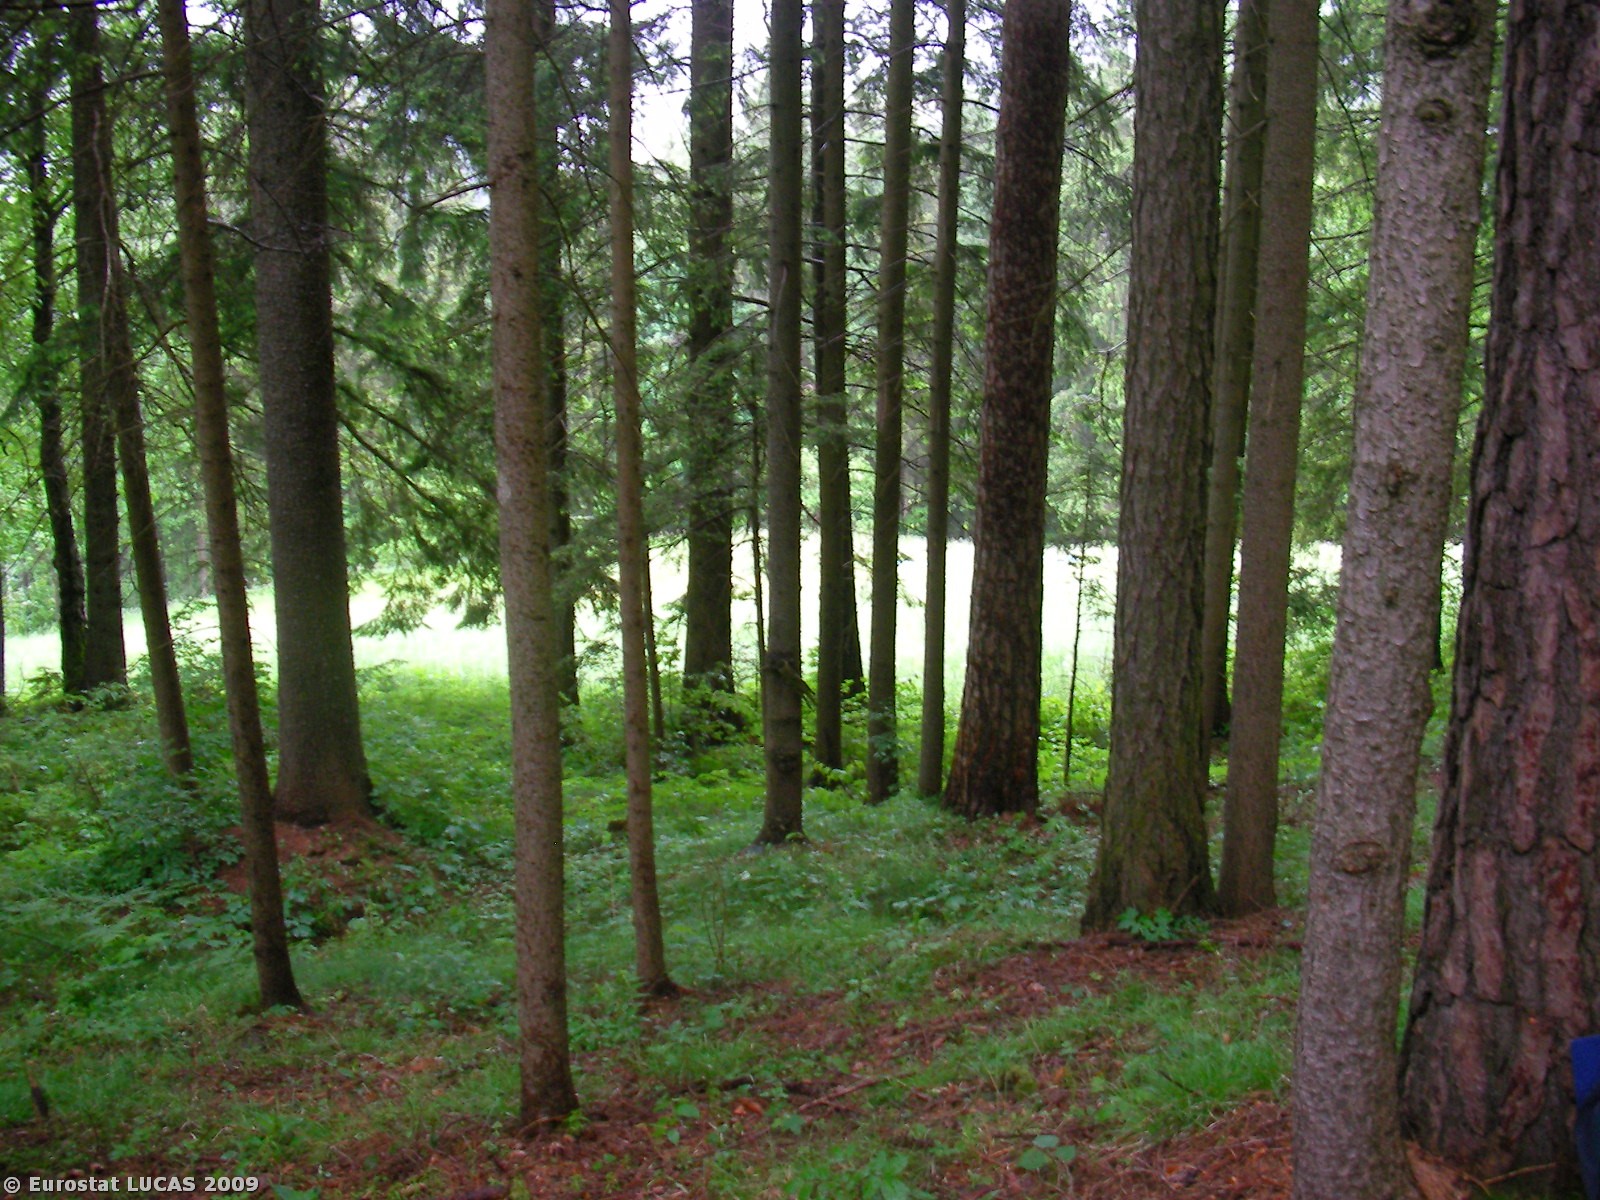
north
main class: Woodland
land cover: Coniferous woodland
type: alpine coniferous forest
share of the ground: > 75 %
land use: Forestry
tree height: > 5 m
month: May
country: AT
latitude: 47.2712
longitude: 15.5654
